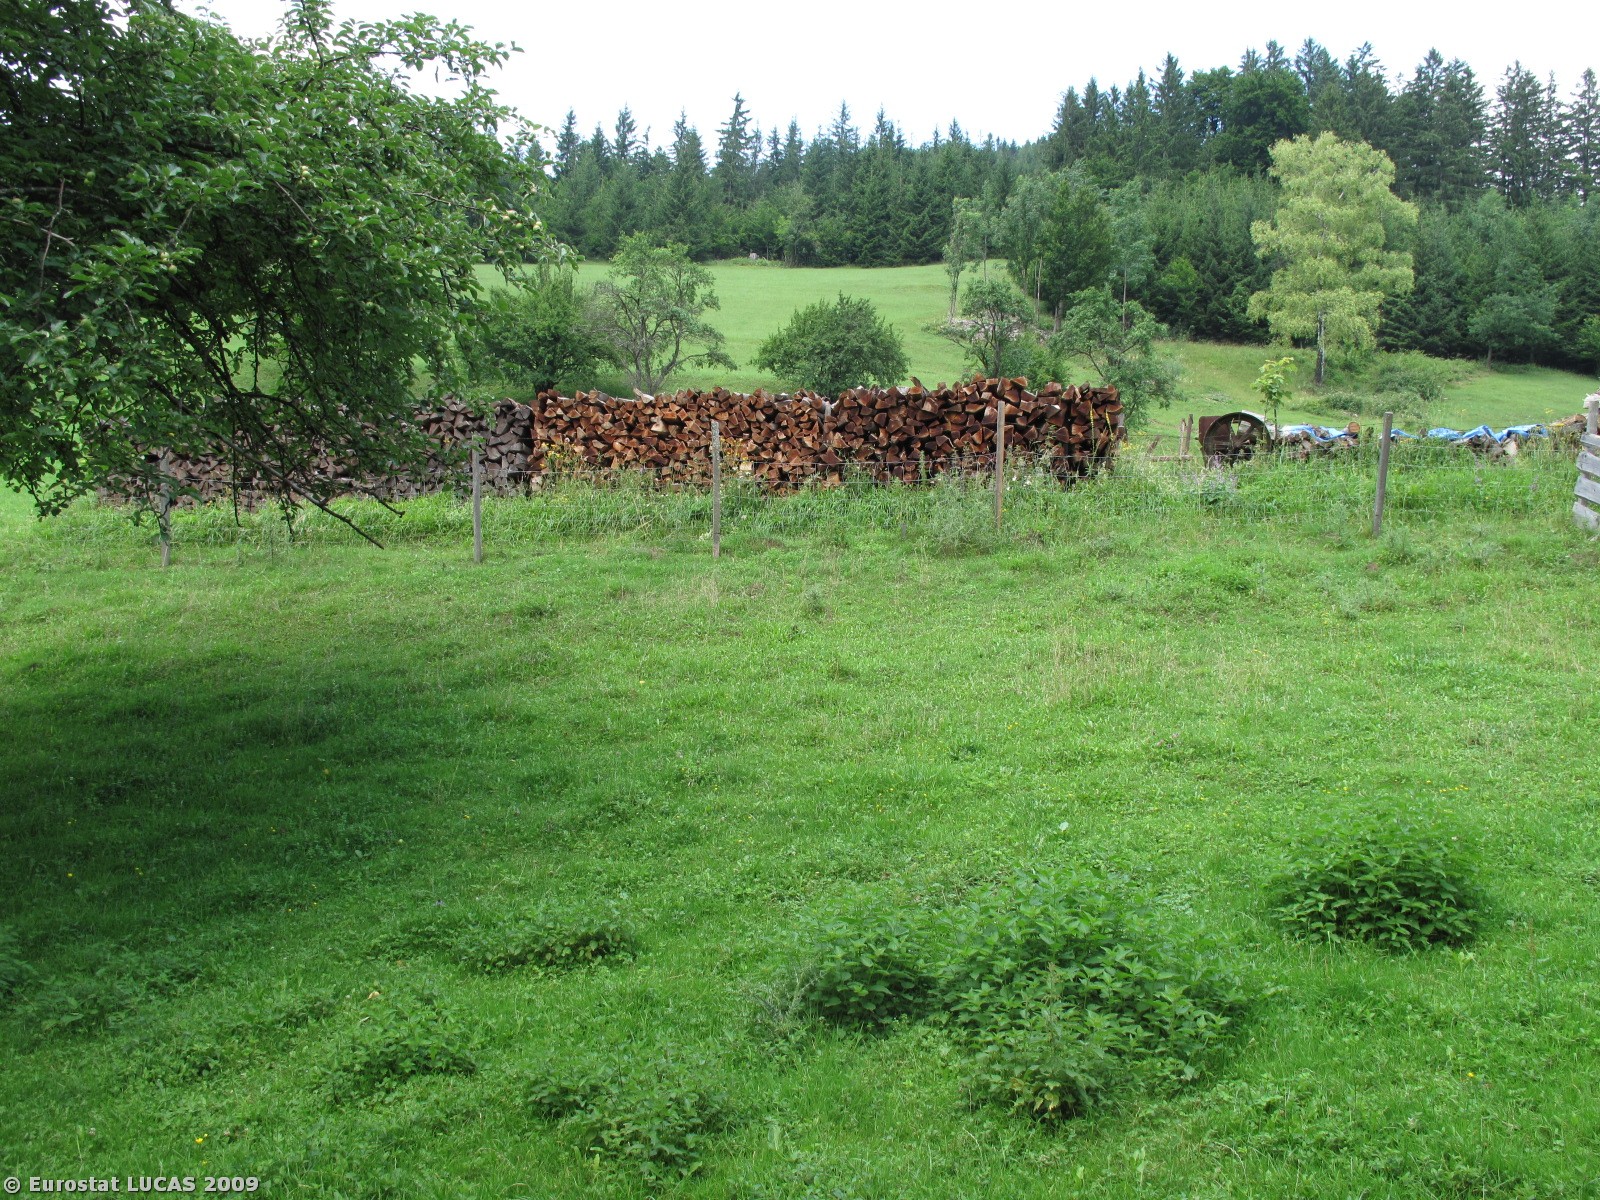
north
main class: Cropland
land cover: Pear fruit
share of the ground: 25 - 50 %
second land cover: Grassland with sparse tree/shrub cover
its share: > 75 %
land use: Agriculture (excluding fallow land and kitchen gardens)
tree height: > 5 m
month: July
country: AT
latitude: 48.0067
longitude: 15.6456
